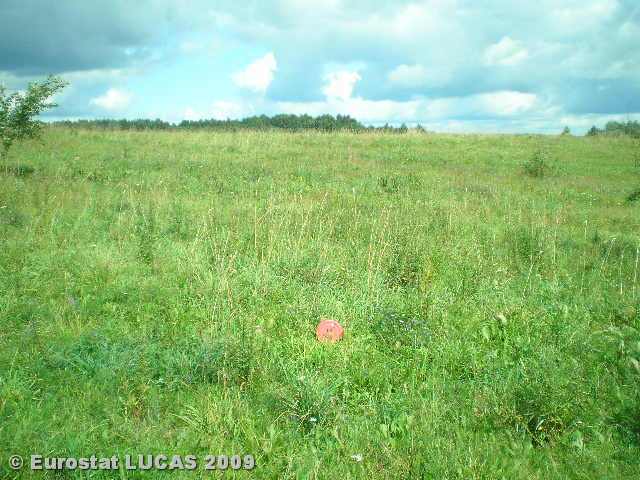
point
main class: Grassland
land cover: Grassland with sparse tree/shrub cover
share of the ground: > 75 %
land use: Agriculture (excluding fallow land and kitchen gardens)
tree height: > 5 m
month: July
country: LT
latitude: 54.9374
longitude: 25.4047
